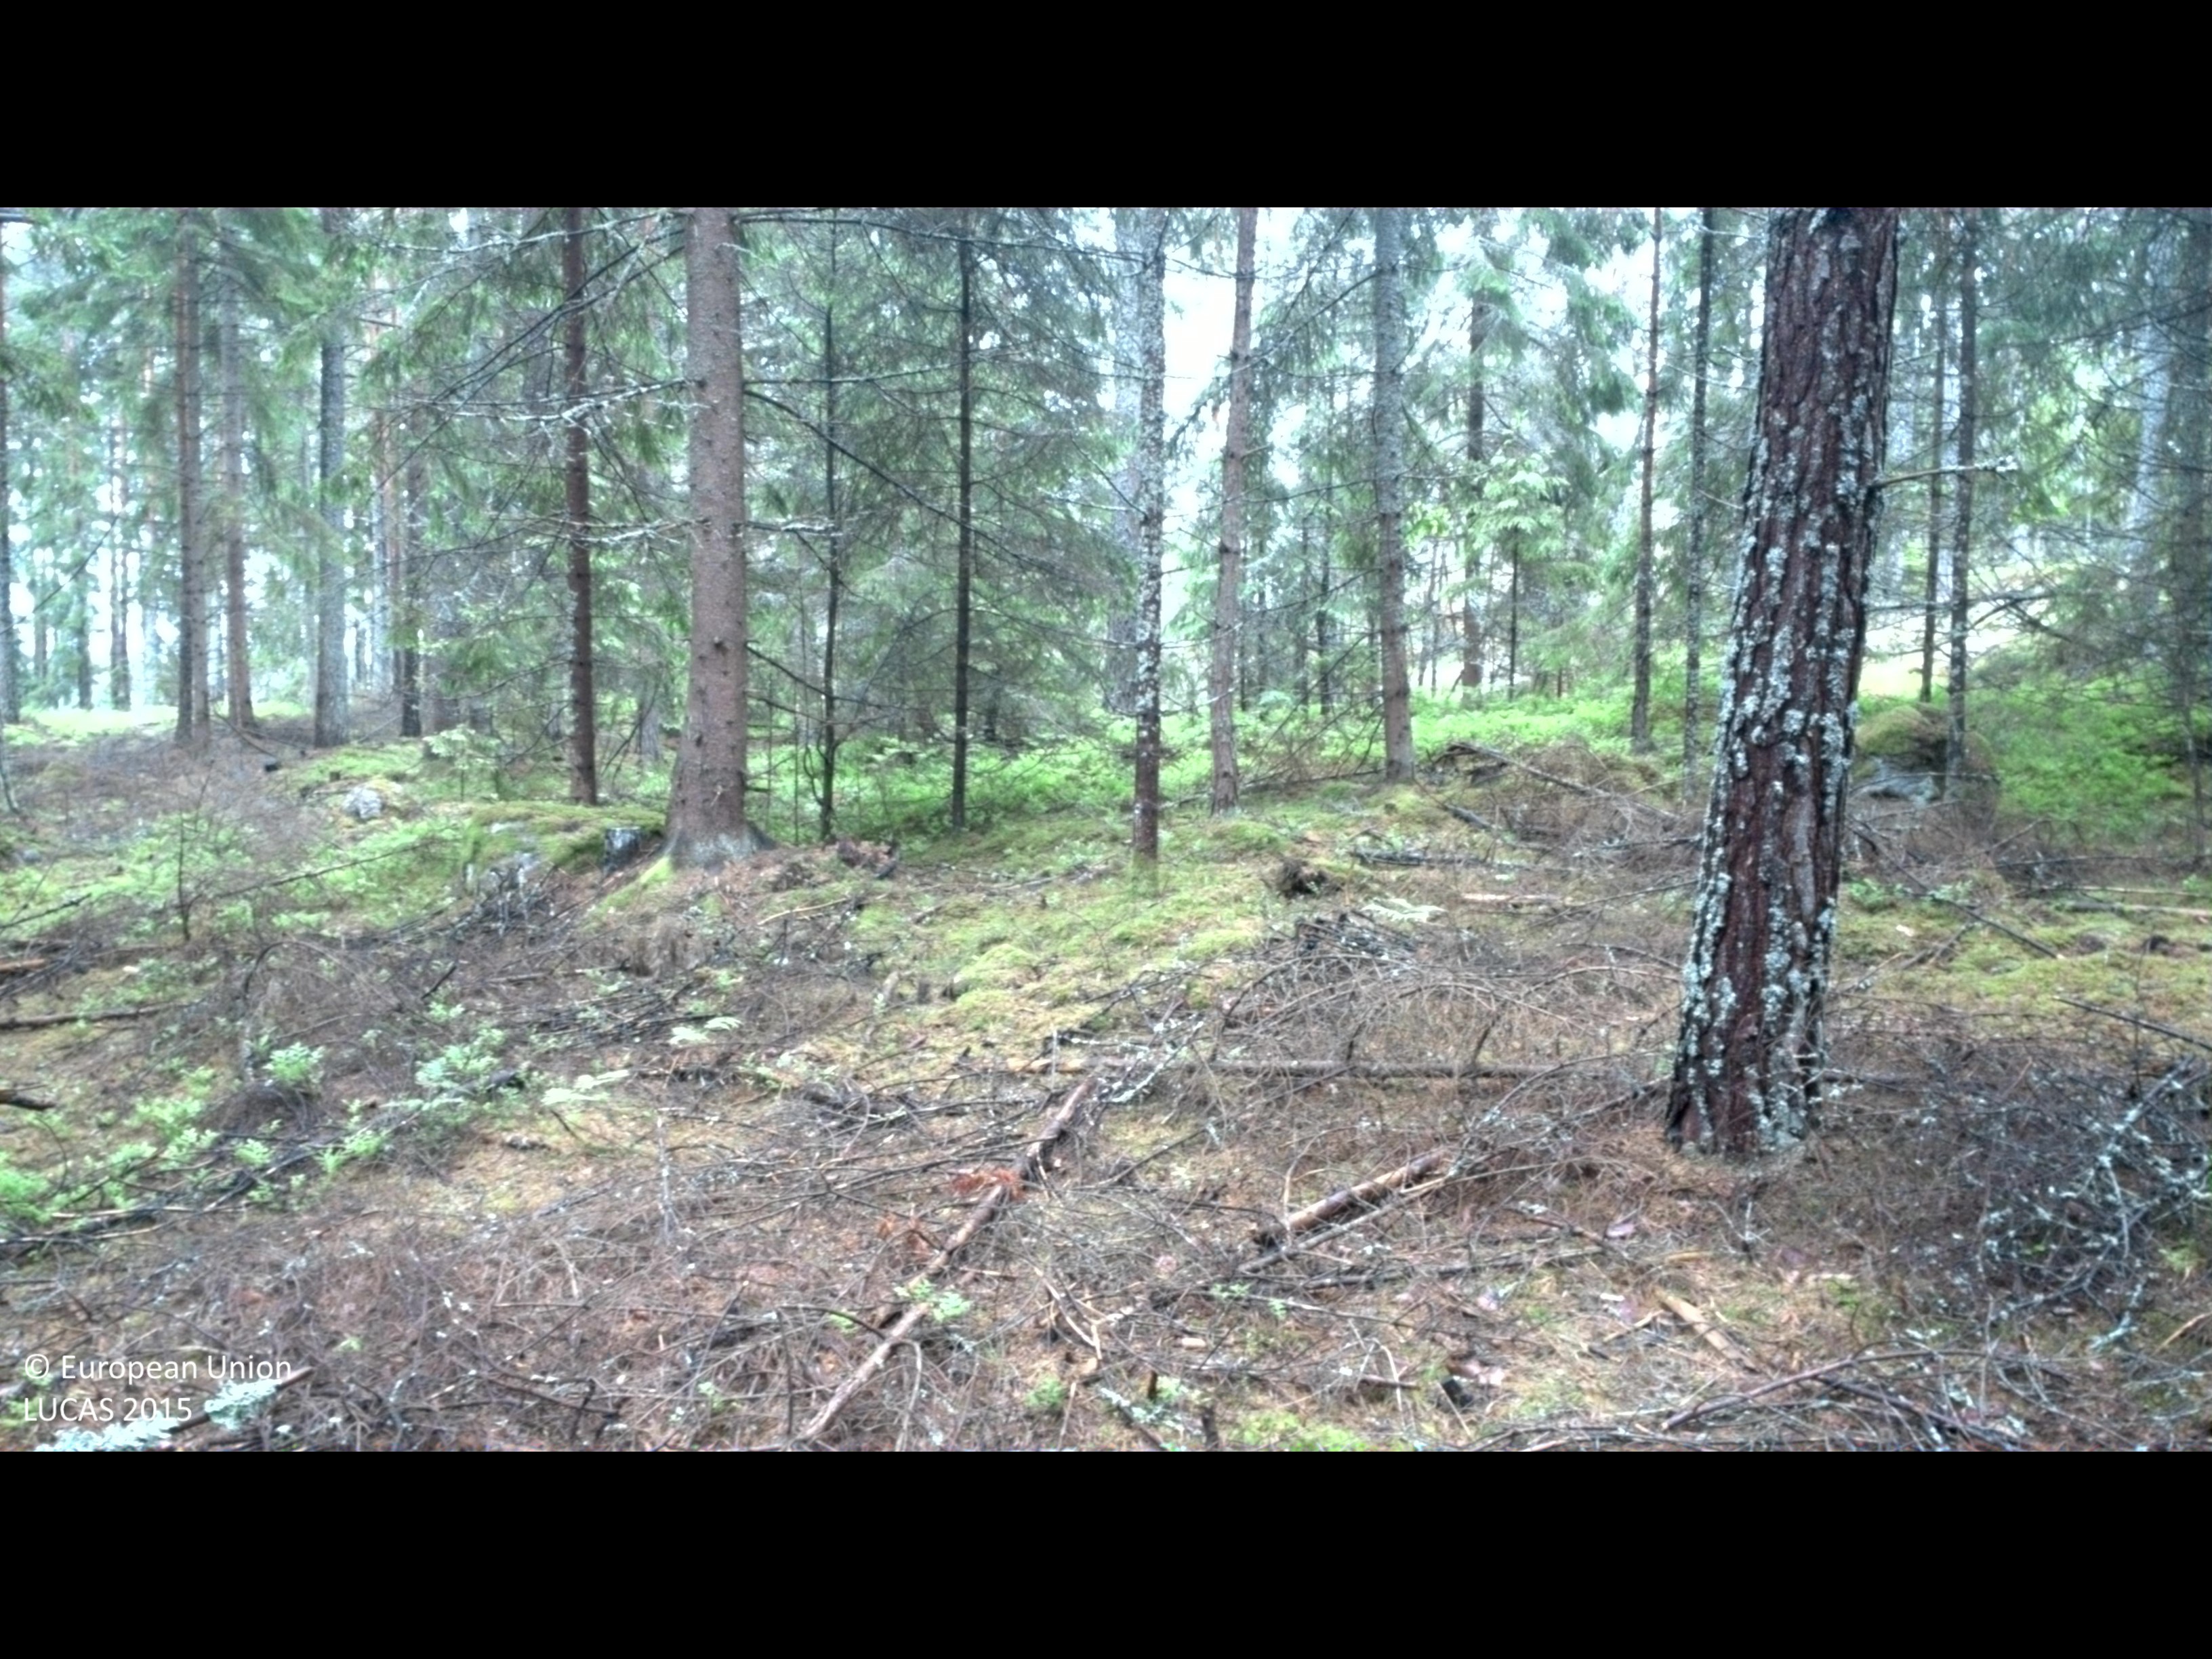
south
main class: Woodland
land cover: Spruce dominated coniferous woodland
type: boreal forest
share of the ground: 50 - 75 %
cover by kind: coniferous forest trees 75 %, shrubs 15 %, lichens and mosses 10 %
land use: Forestry
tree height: > 5 m
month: June
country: SE
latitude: 58.0514
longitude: 16.3510
